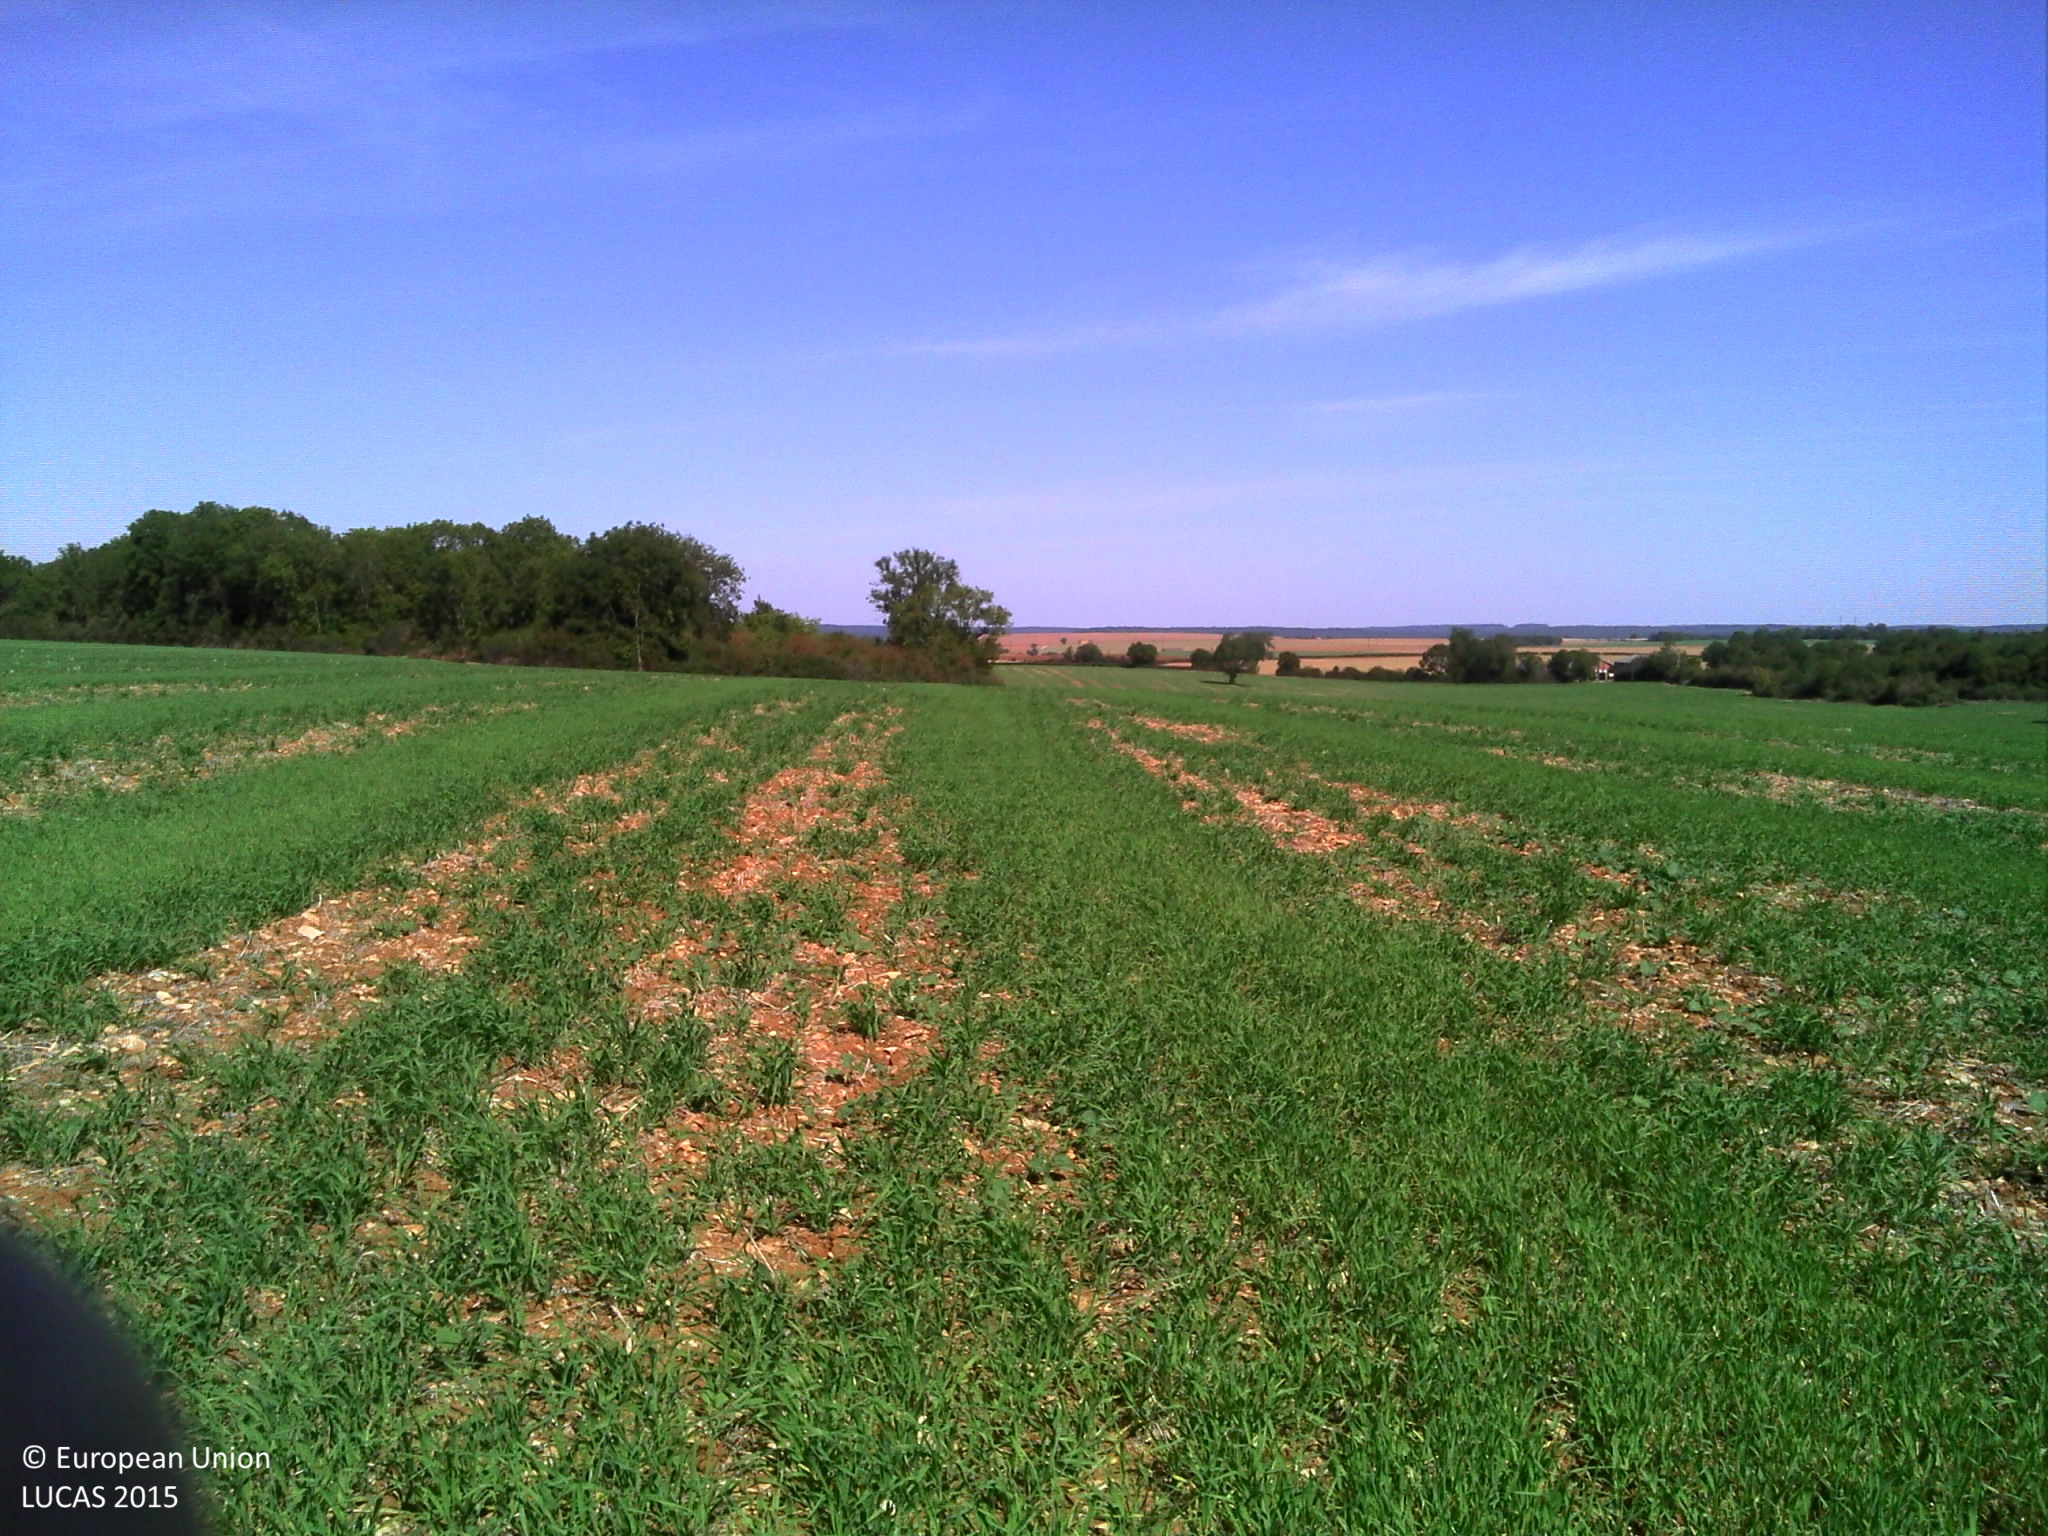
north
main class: Cropland
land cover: Barley
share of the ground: > 75 %
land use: Agriculture (excluding fallow land and kitchen gardens)
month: September
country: FR
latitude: 47.5569
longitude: 4.3772
